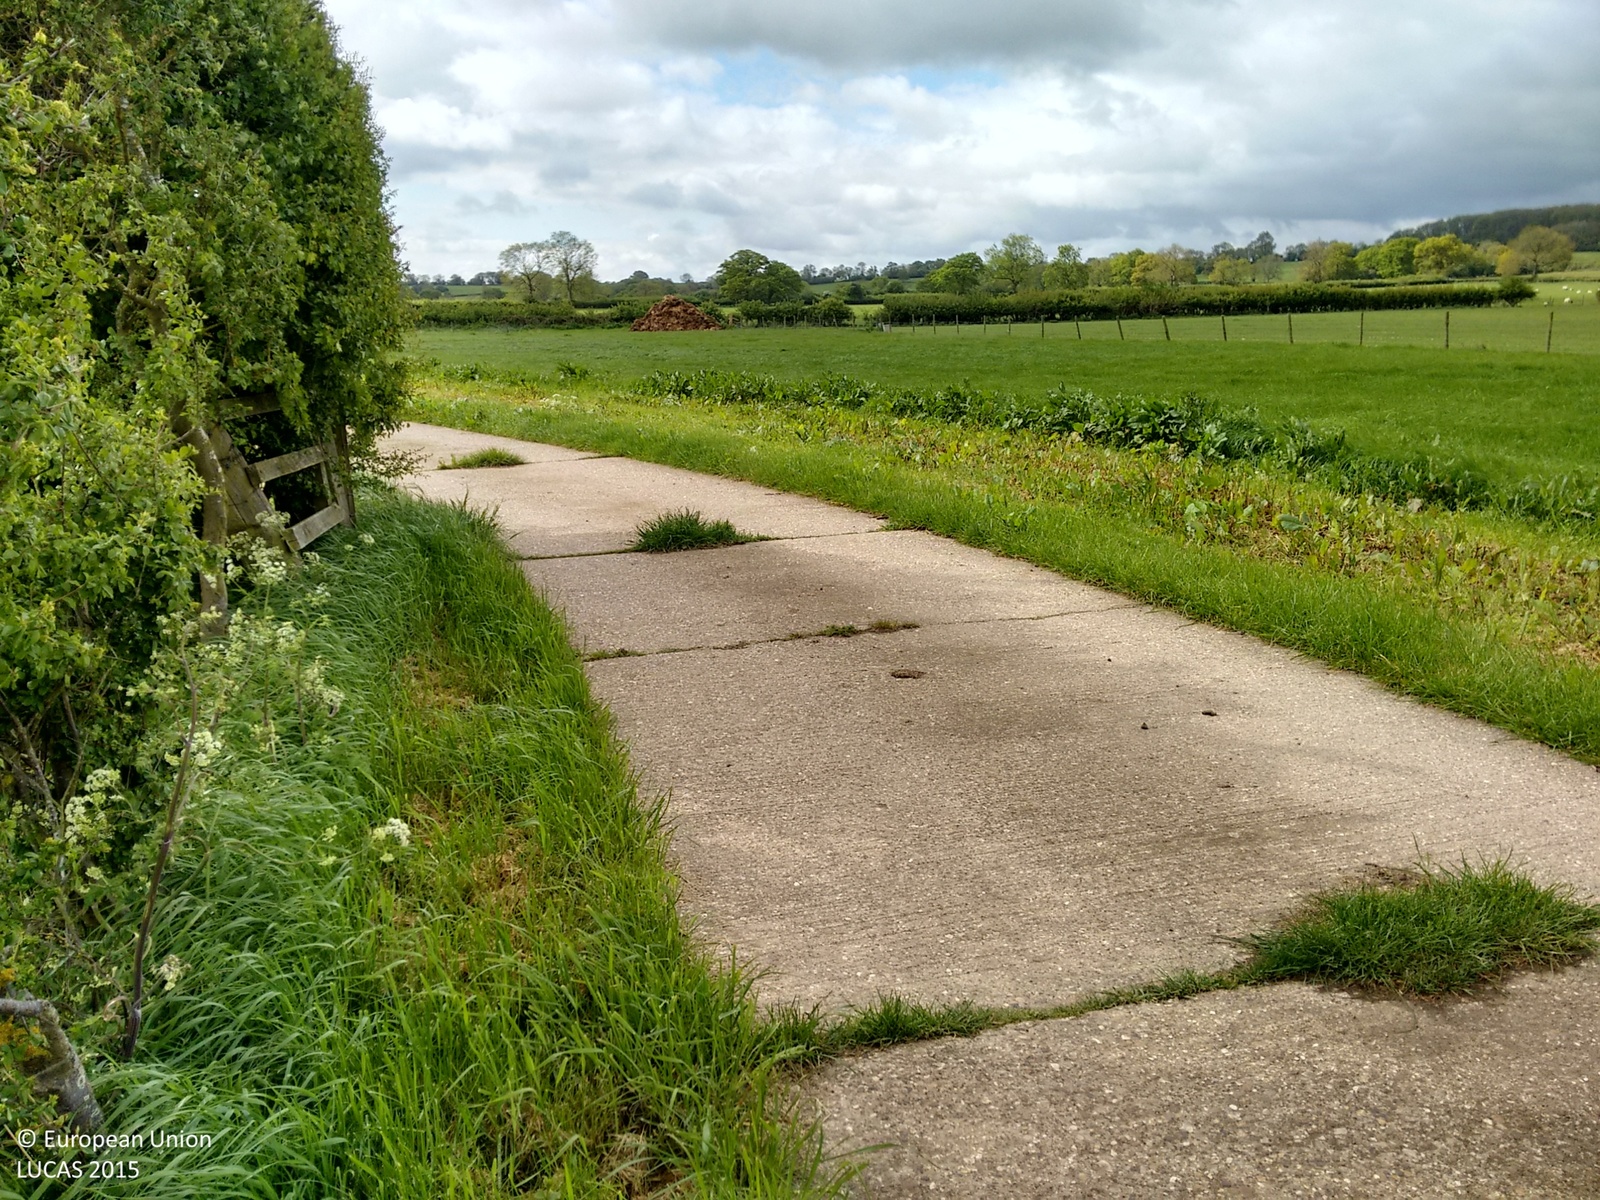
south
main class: Grassland
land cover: Grassland without tree/shrub cover
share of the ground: > 75 %
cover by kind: herbaceous plants 100 %
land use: Agriculture (excluding fallow land and kitchen gardens)
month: May
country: GB
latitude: 52.1992
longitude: -1.2995
